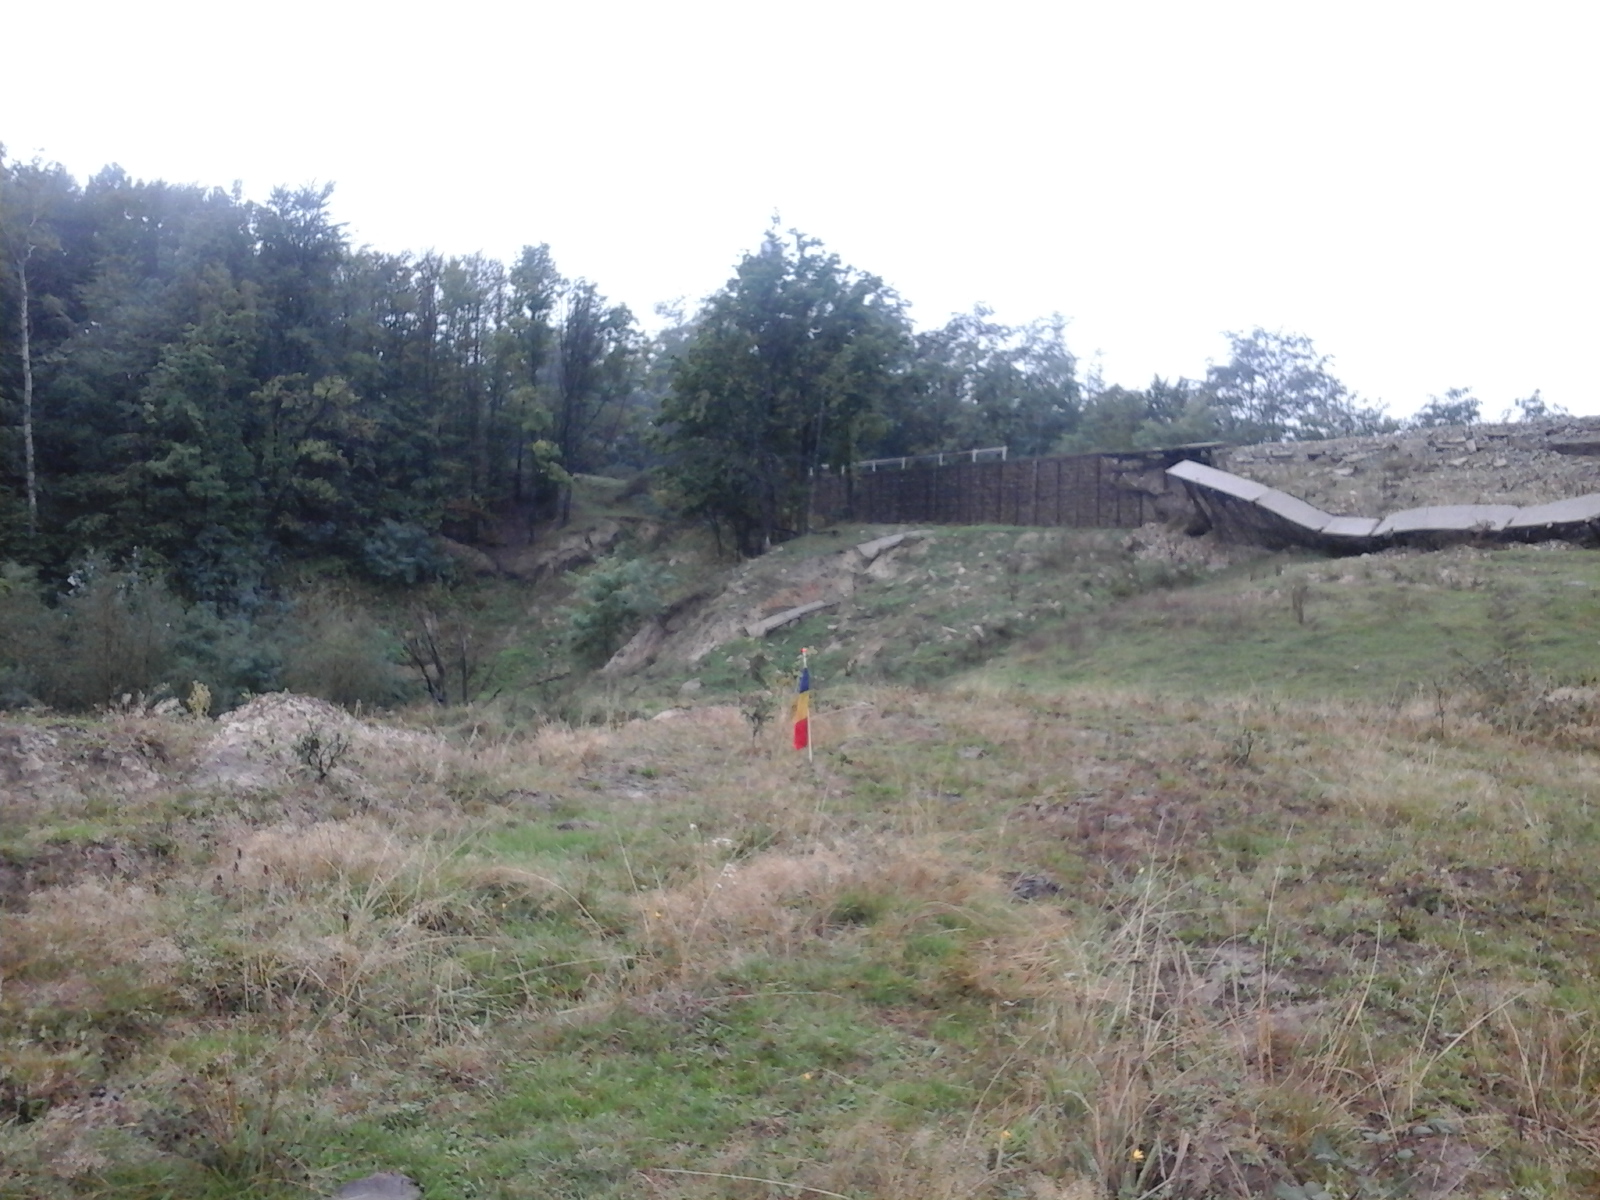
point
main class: Grassland
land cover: Spontaneously vegetated surfaces
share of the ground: > 75 %
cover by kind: herbaceous plants 100 %
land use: Fallow land
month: September
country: RO
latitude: 44.9839
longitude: 23.7456
